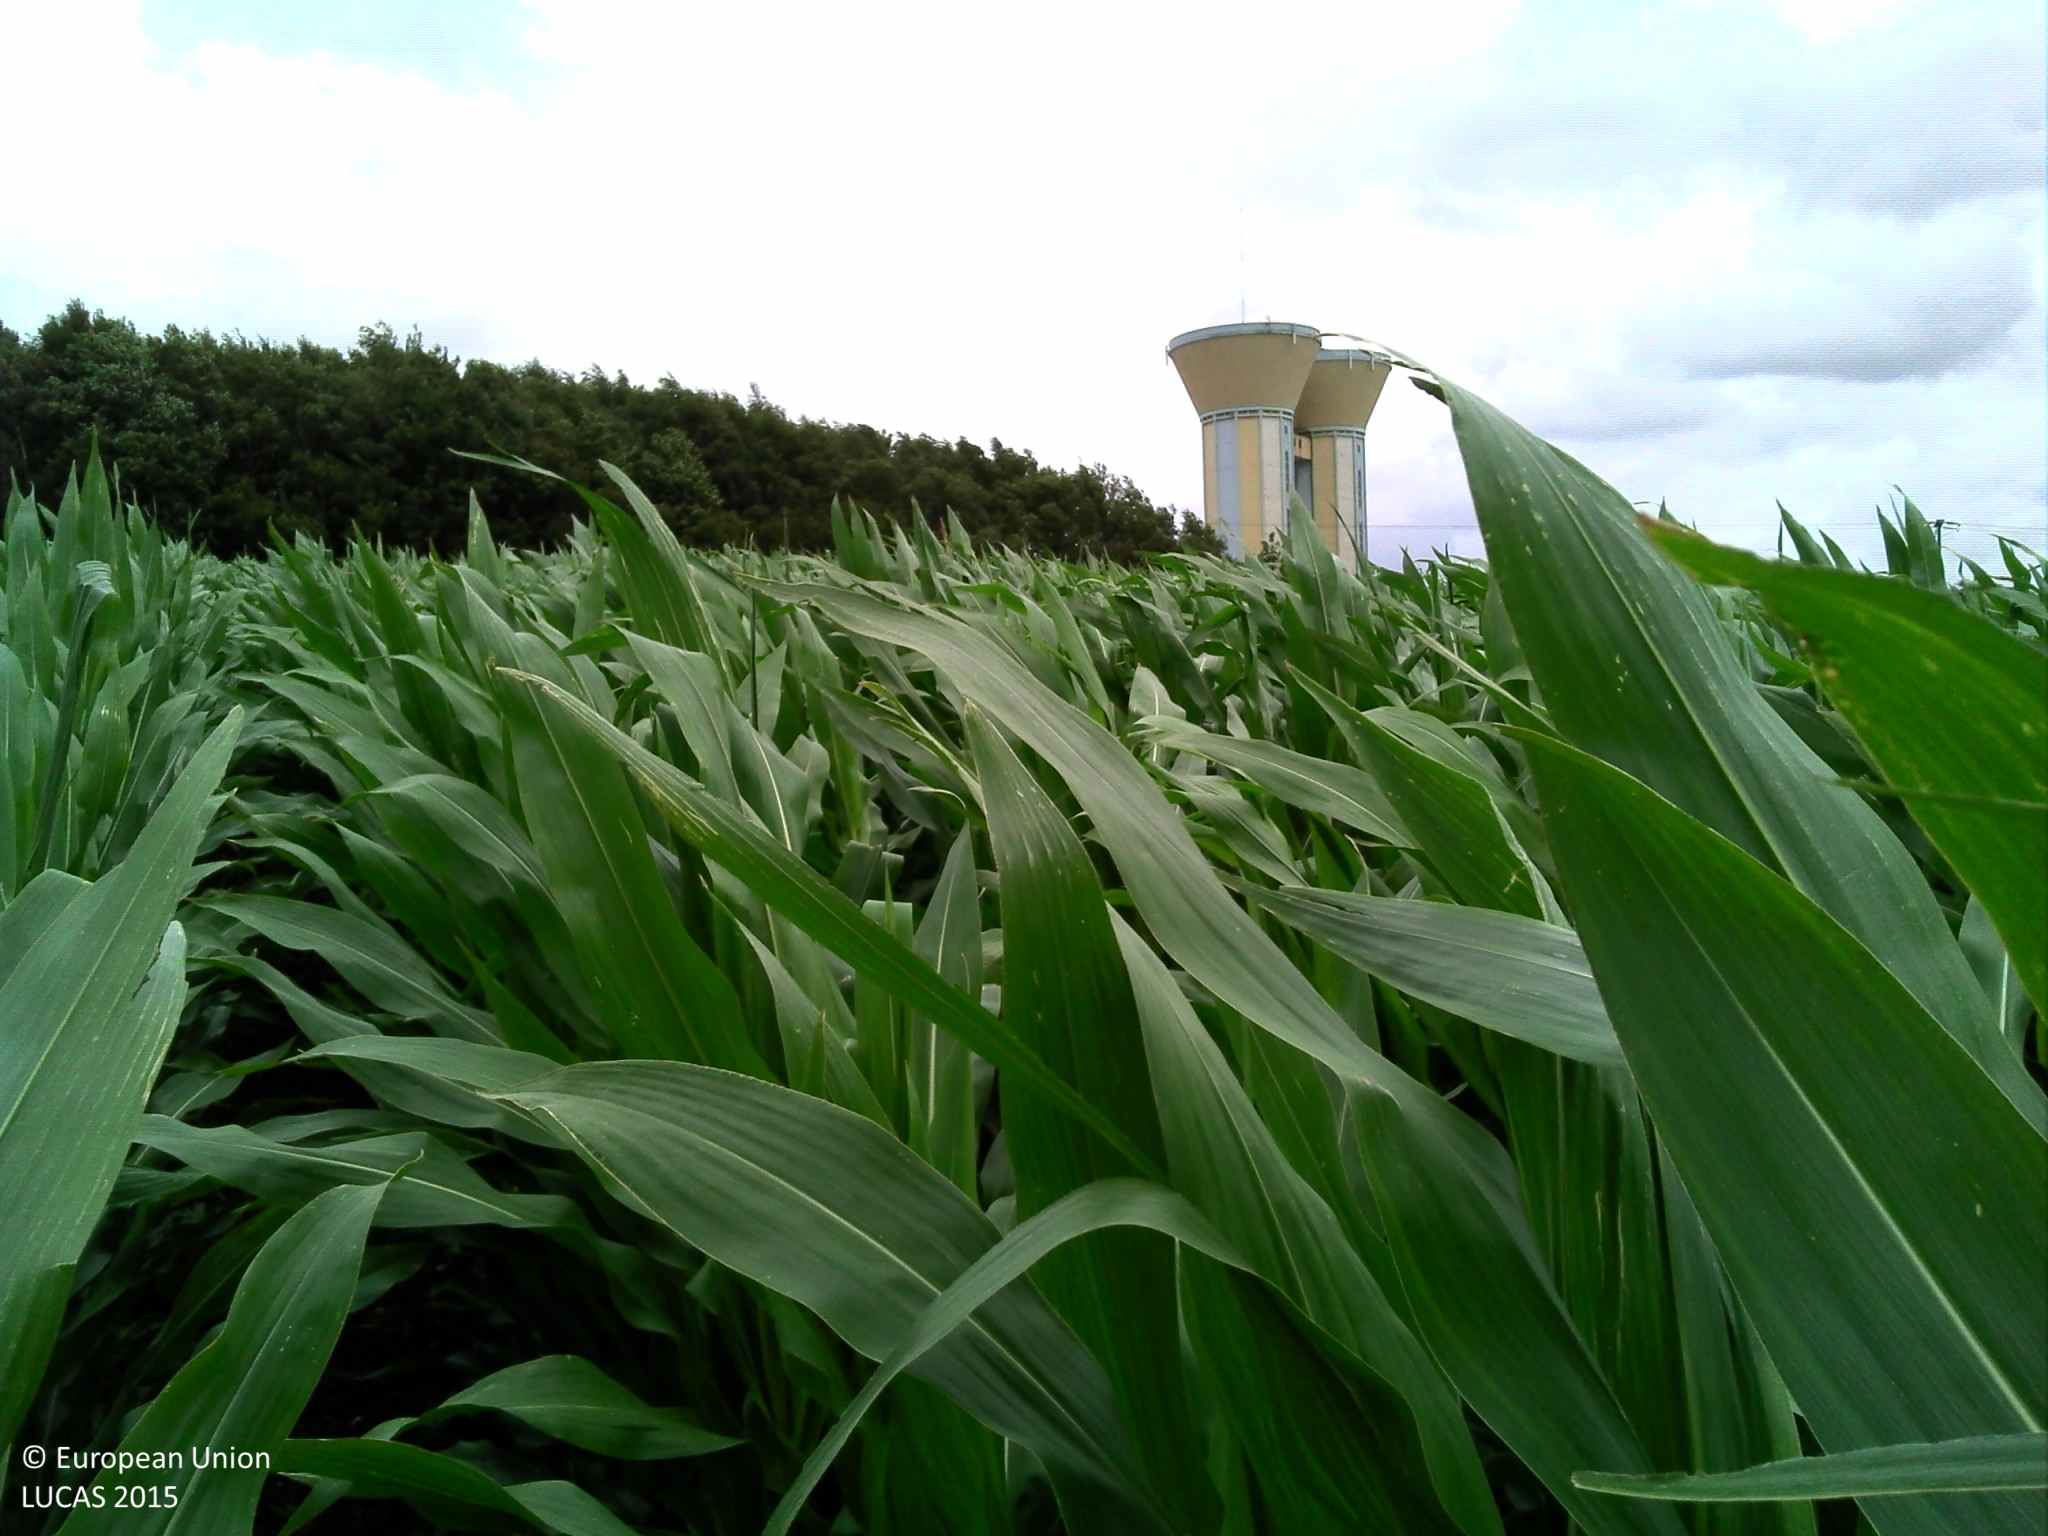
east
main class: Cropland
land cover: Maize
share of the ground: > 75 %
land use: Agriculture (excluding fallow land and kitchen gardens)
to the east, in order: Maize; Grass margins; Abandoned hedges; Grassland without tree/shrub cover; Electric lines; Managed hedges; Grass margins; Paved roads, cycling and walking lanes; Grass margins; Ditches and canals; Grass margins; Fences; Grassland without tree/shrub cover; Grassland with sparse tree/shrub cover
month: July
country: FR
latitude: 50.7435
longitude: 2.4049
